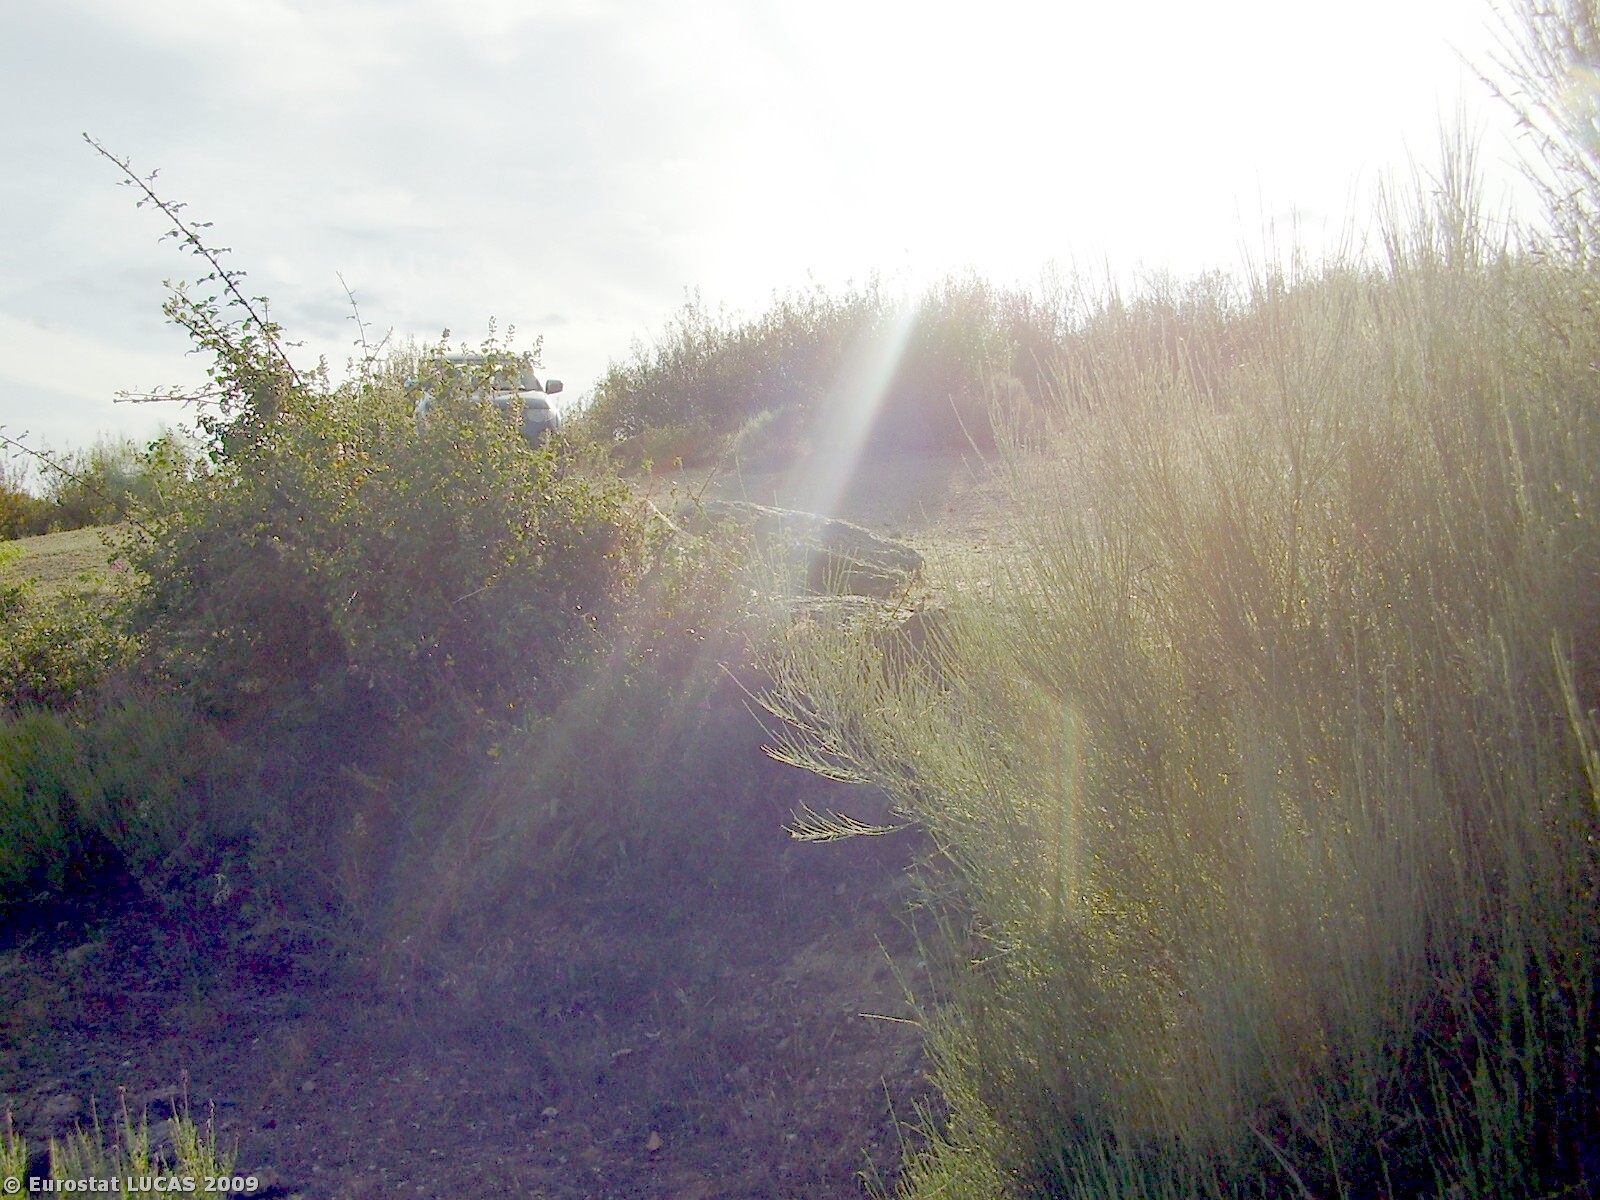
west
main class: Grassland
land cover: Grassland with sparse tree/shrub cover
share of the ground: 50 - 75 %
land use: Forestry
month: June
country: PT
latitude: 41.4797
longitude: -6.7914
